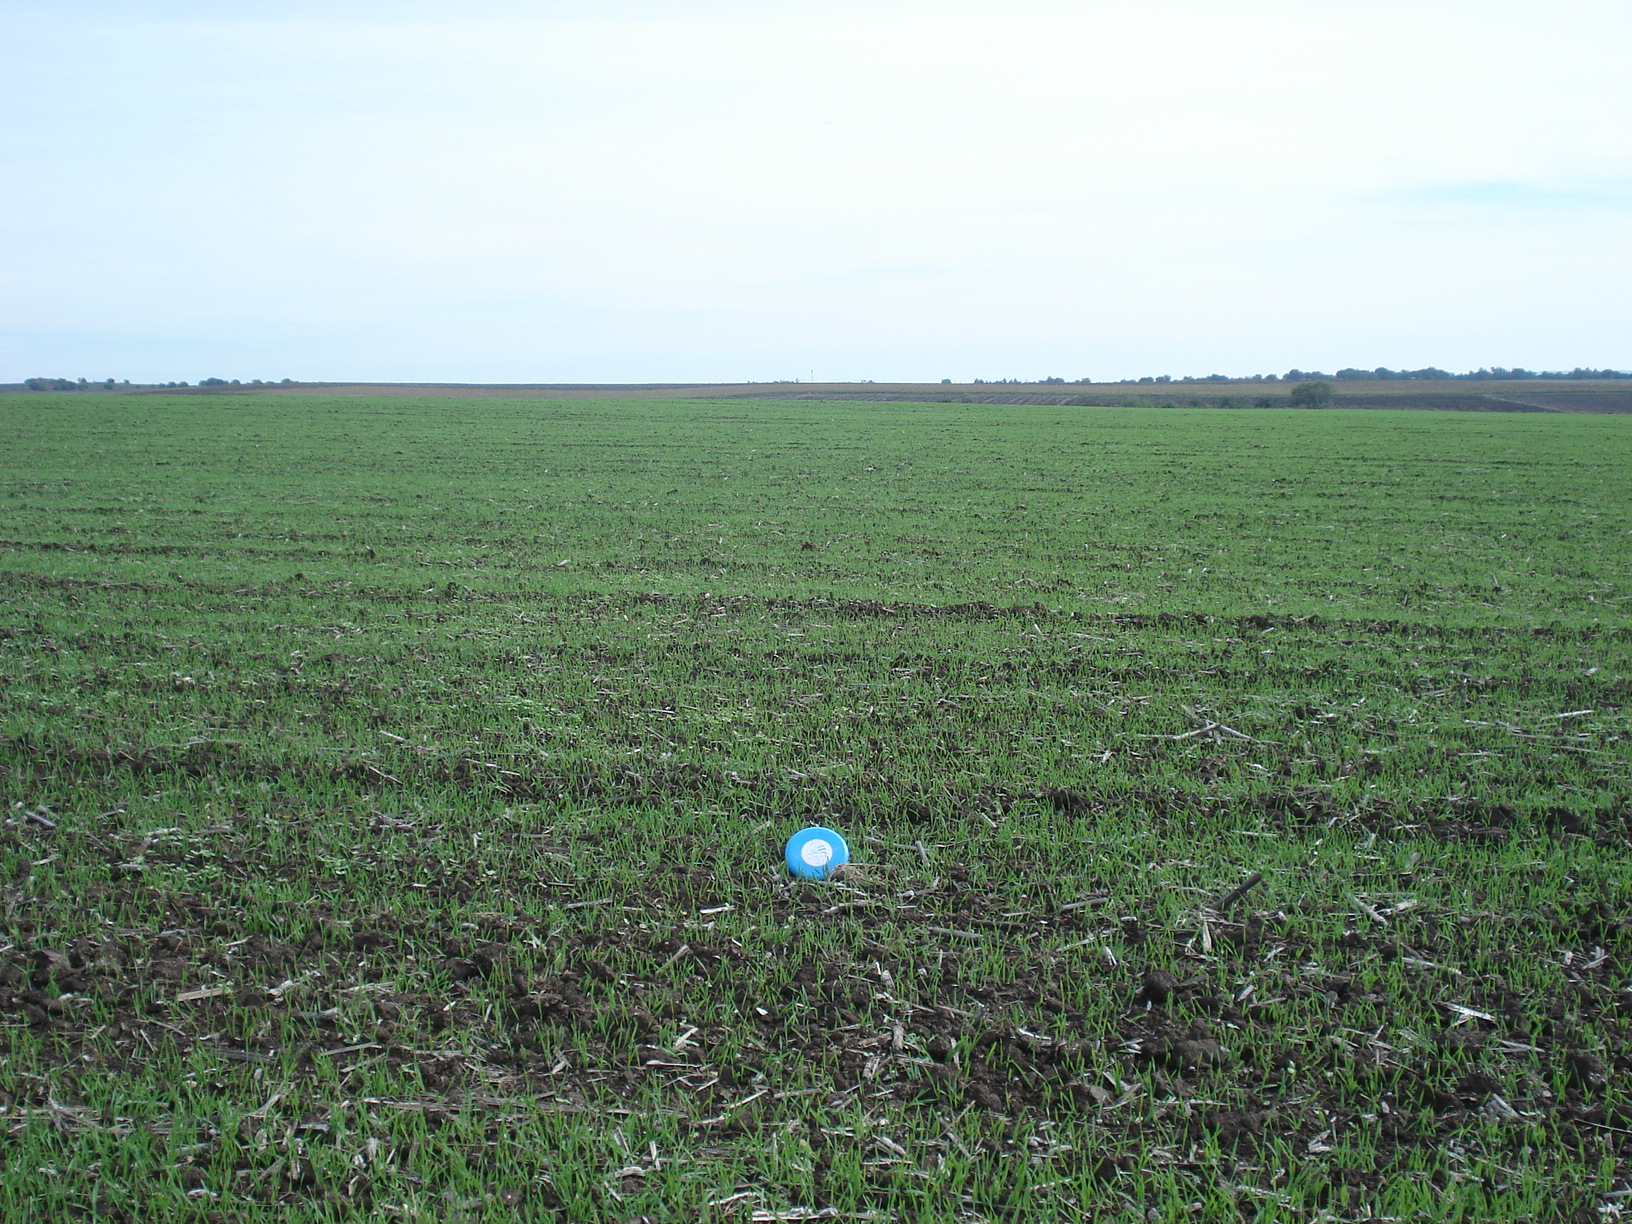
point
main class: Cropland
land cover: Common wheat
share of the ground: 25 - 50 %
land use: Agriculture (excluding fallow land and kitchen gardens)
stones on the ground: < 10 %
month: October
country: BG
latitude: 43.3064
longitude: 25.3761
